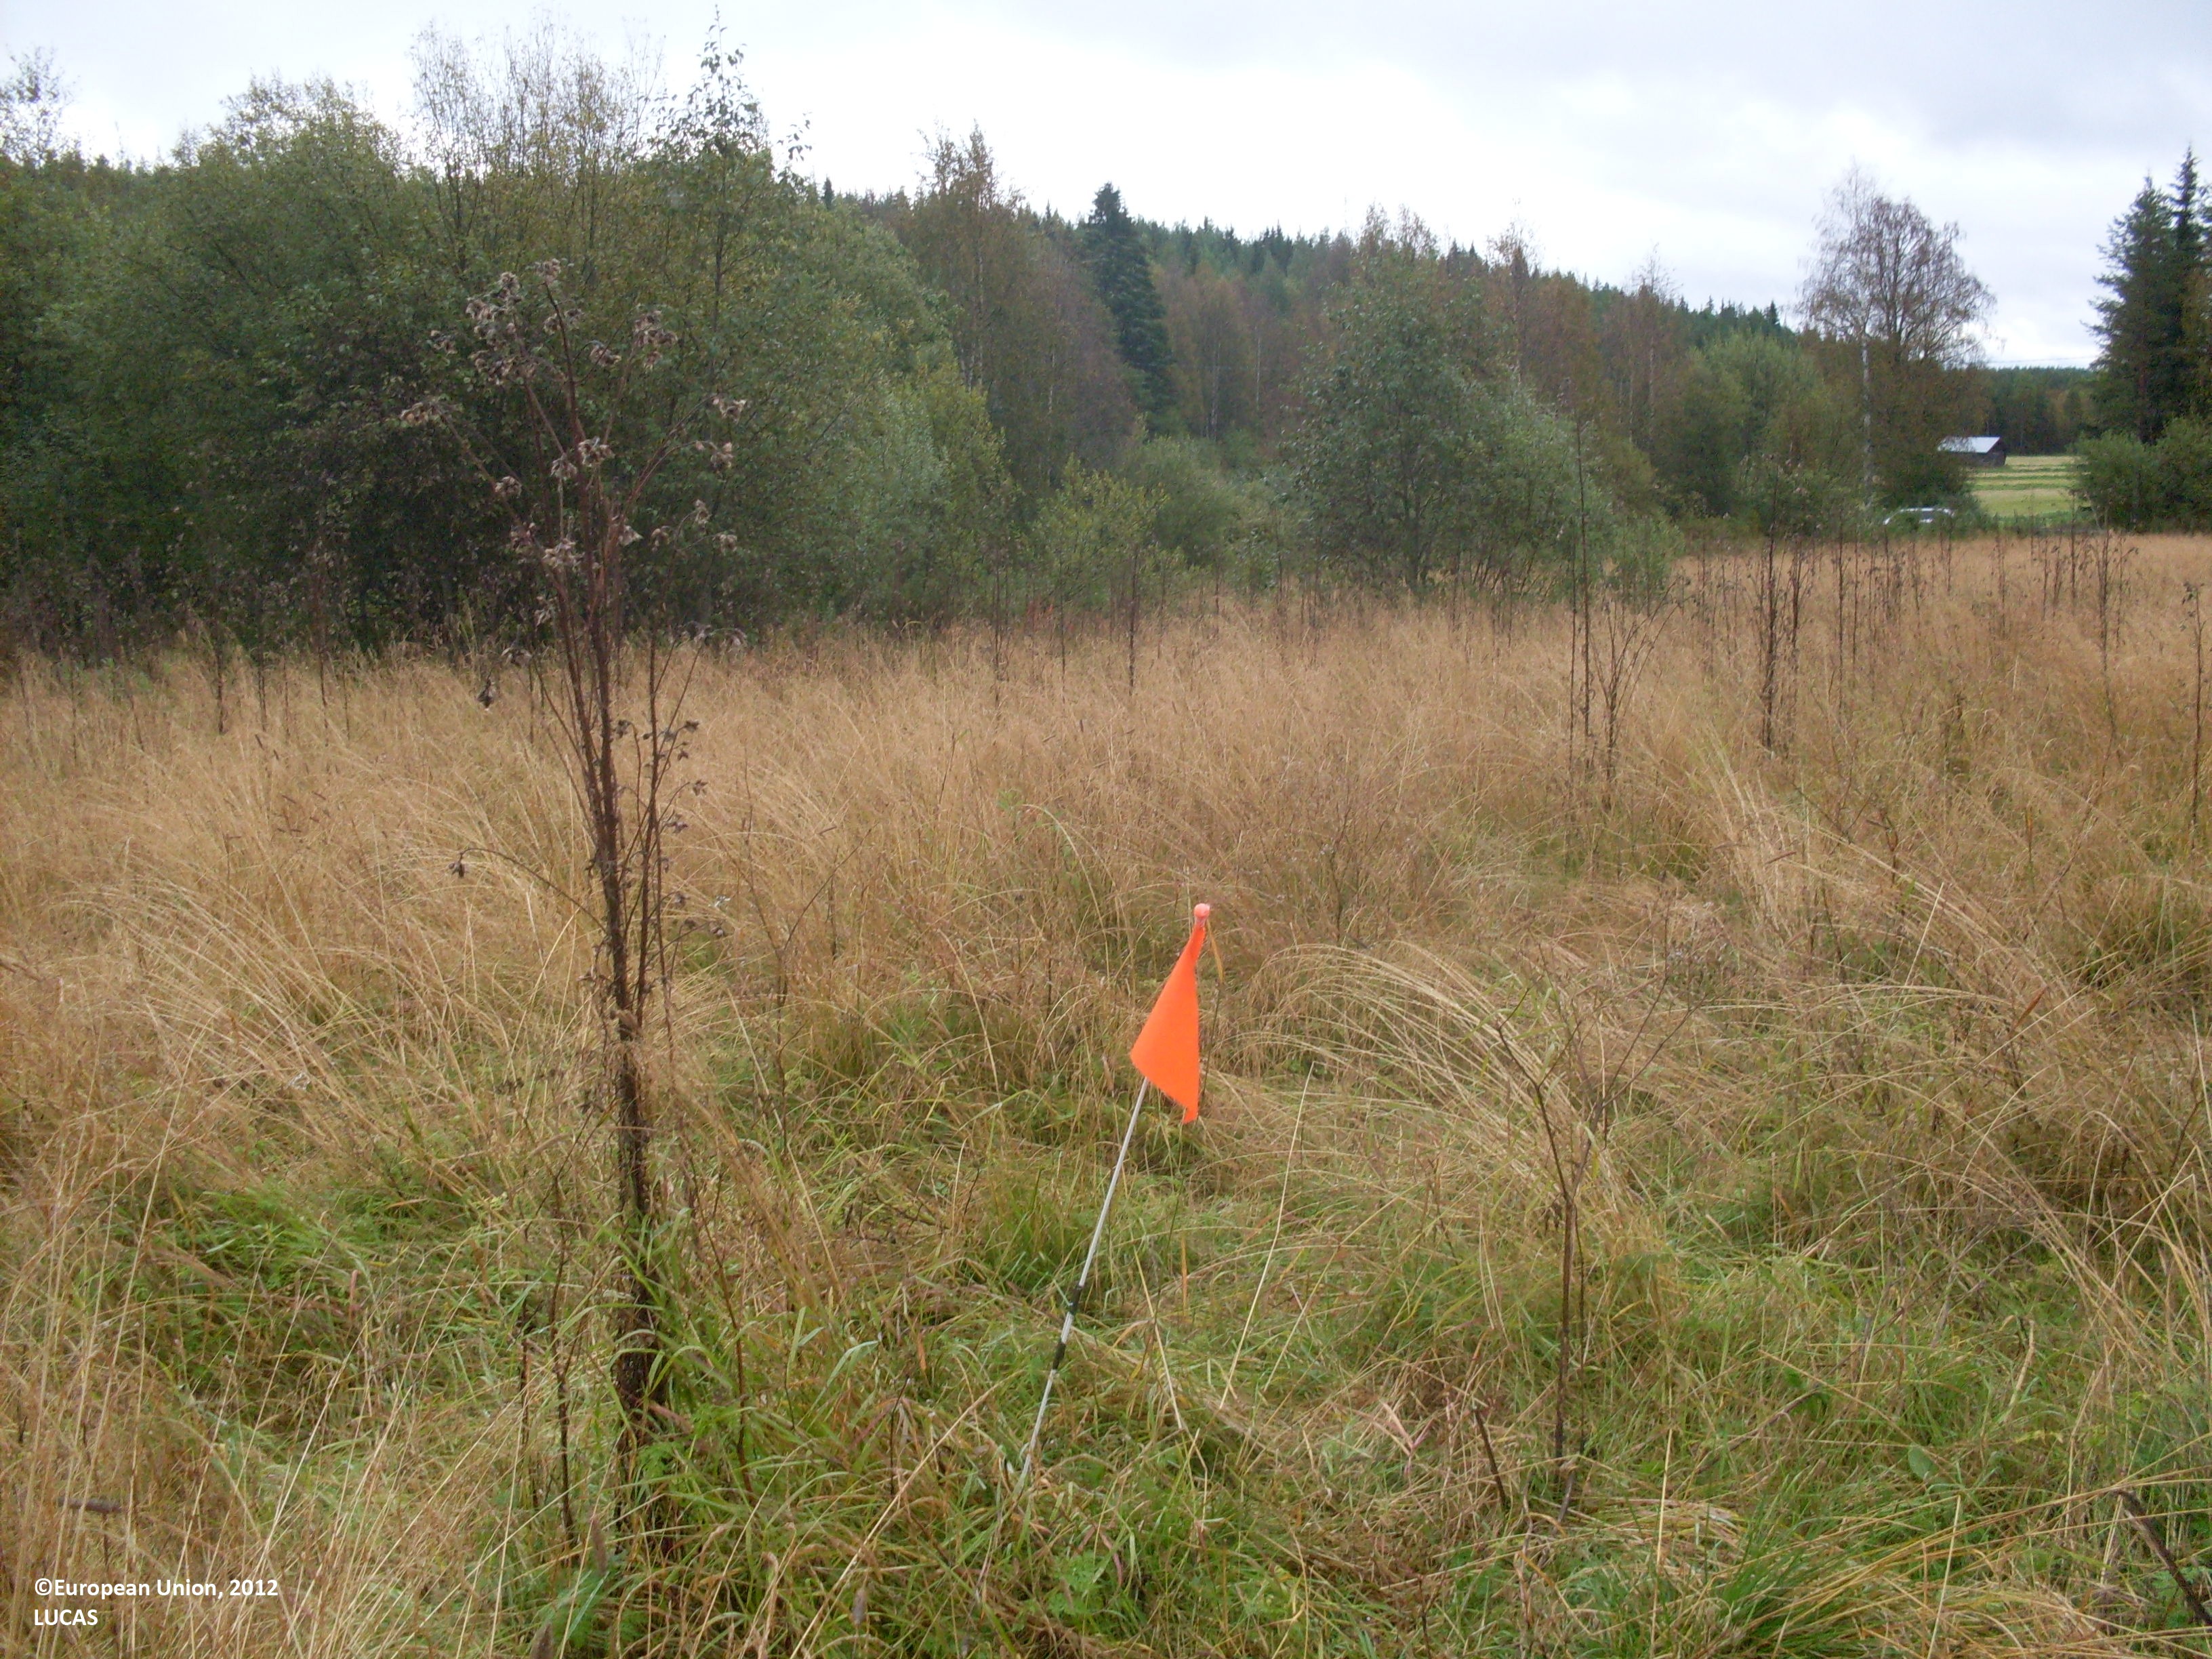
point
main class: Grassland
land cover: Grassland without tree/shrub cover
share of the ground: > 75 %
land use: Agriculture (excluding fallow land and kitchen gardens)
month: September
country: FI
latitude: 64.1477
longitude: 29.6054
